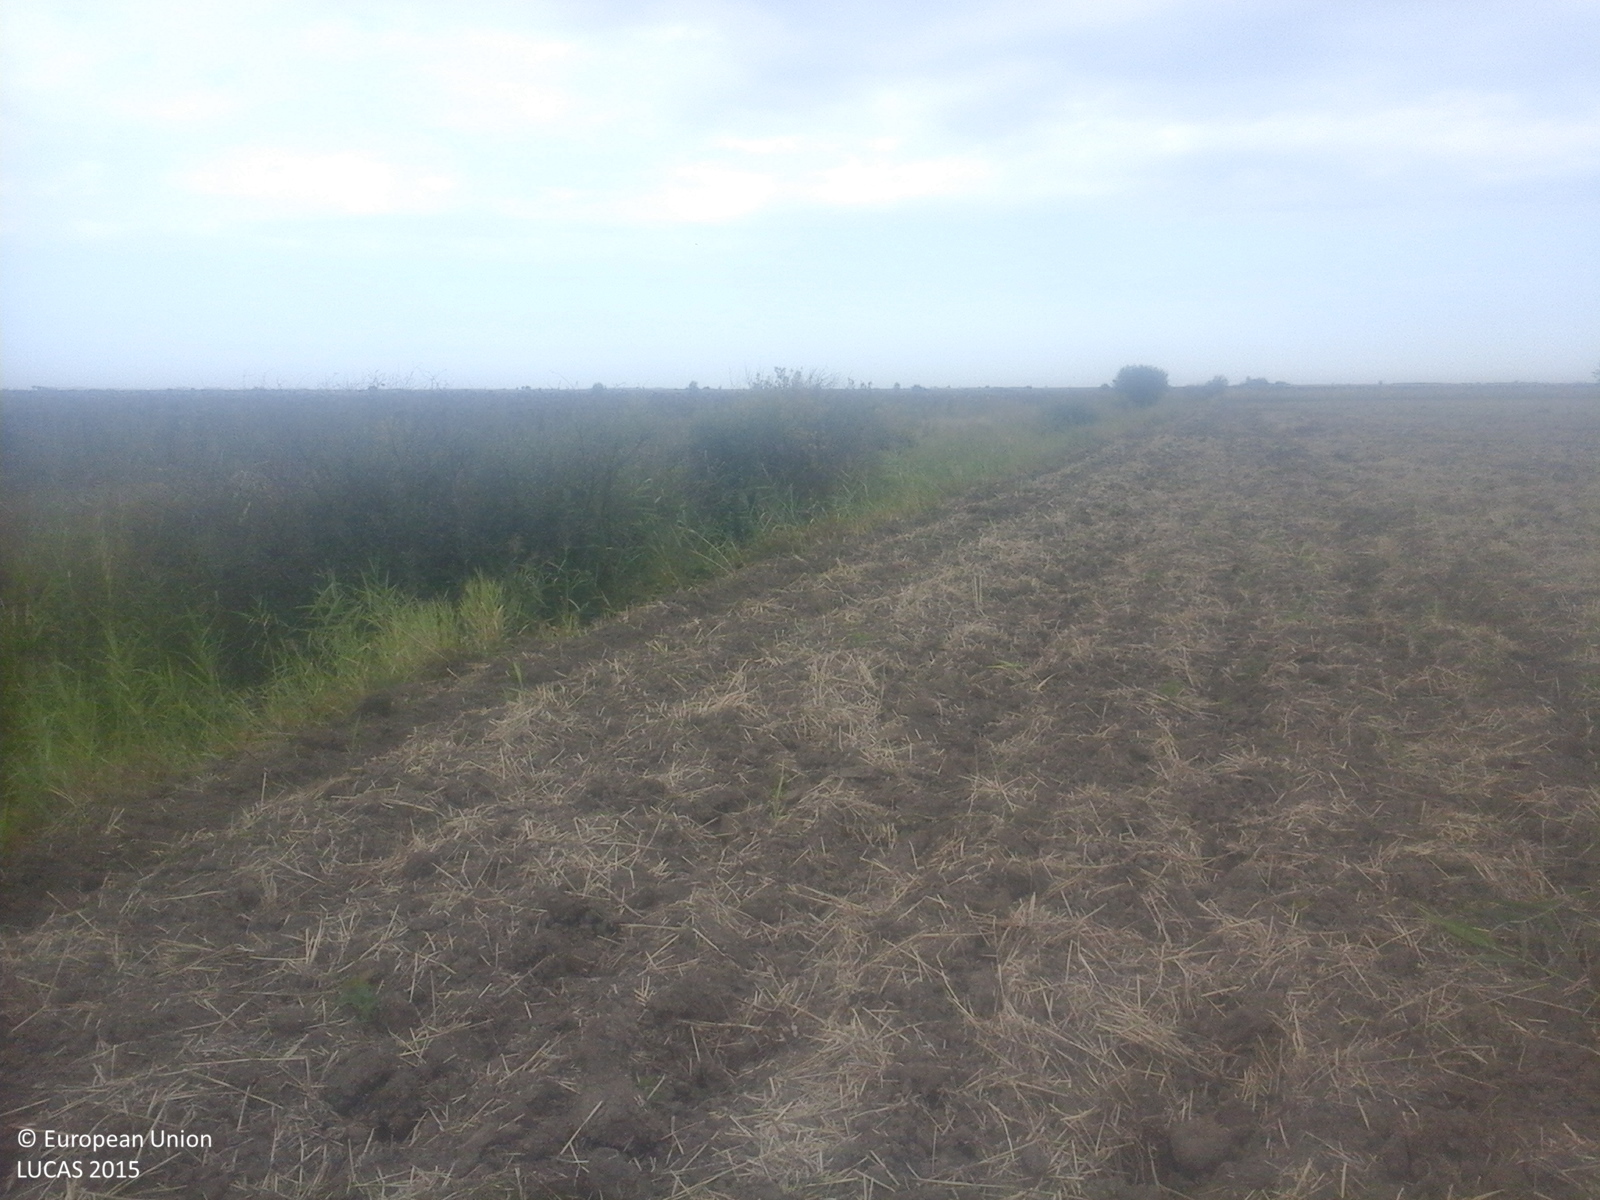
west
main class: Cropland
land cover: Common wheat
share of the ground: < 10 %
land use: Agriculture (excluding fallow land and kitchen gardens)
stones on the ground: < 10 %
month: September
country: RO
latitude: 47.7477
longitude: 22.6381
